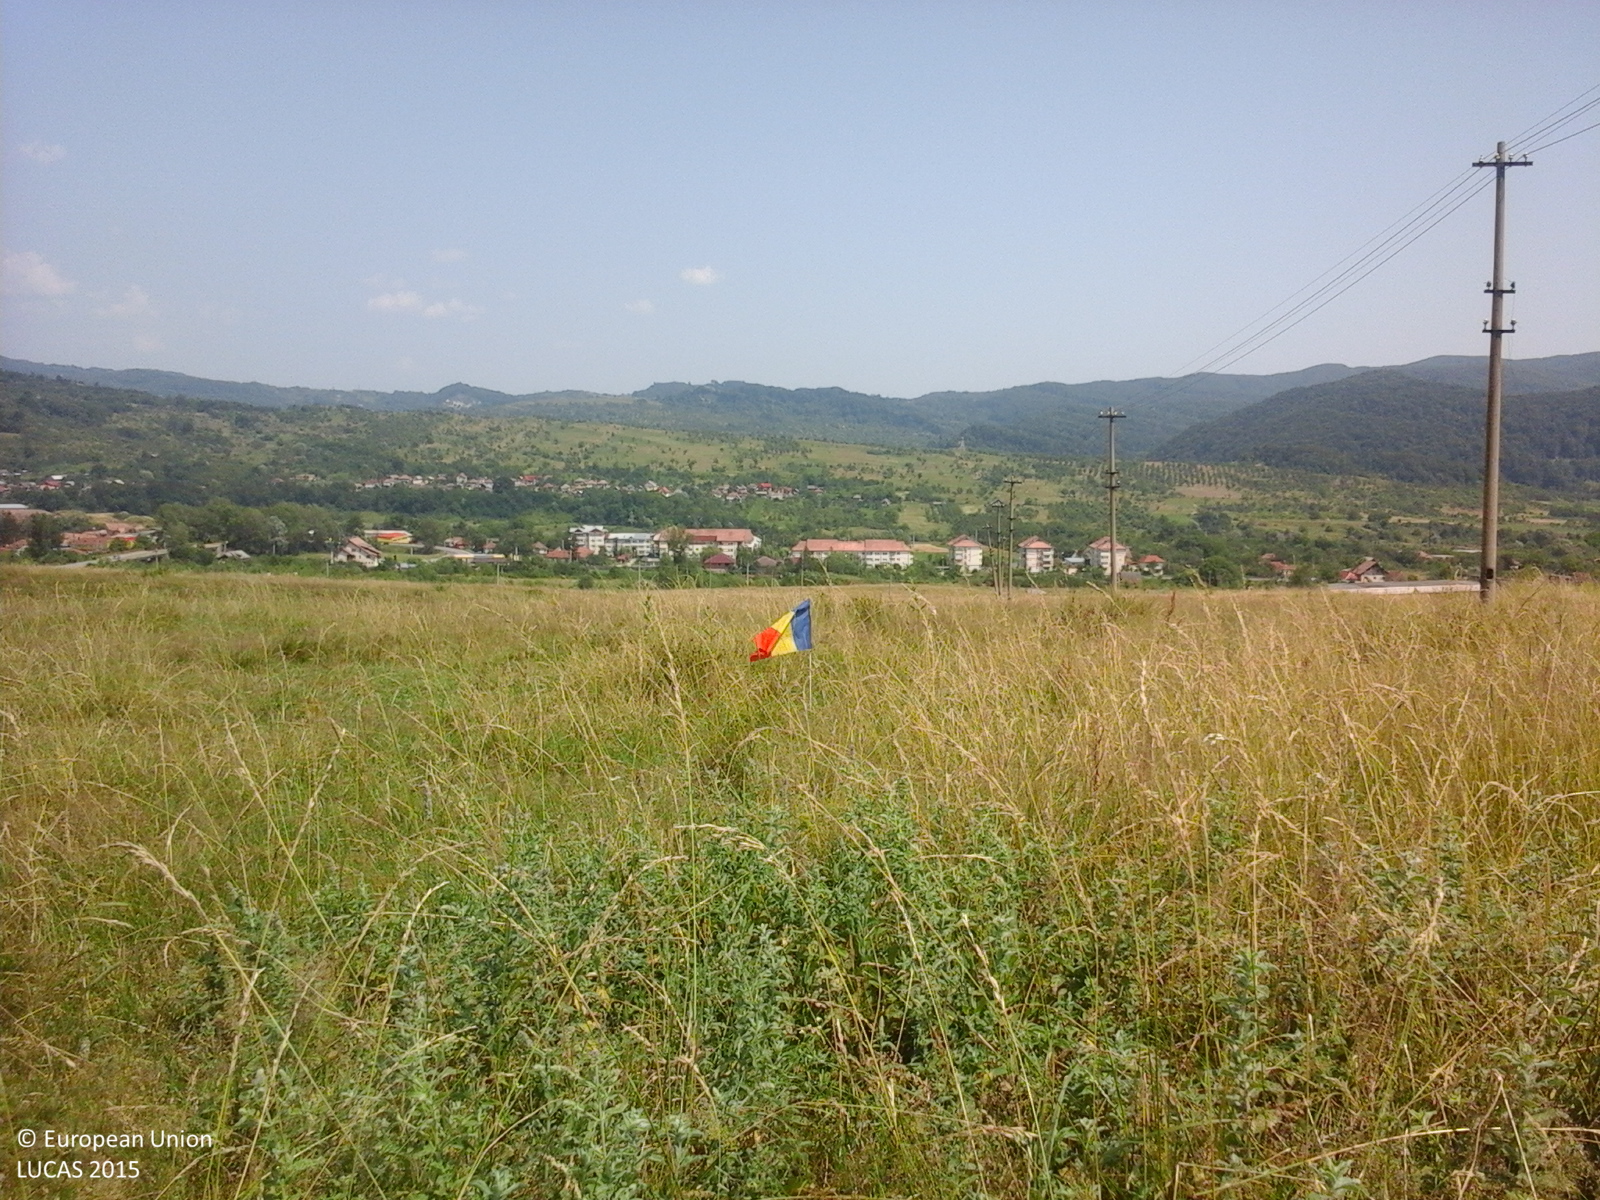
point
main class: Grassland
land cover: Grassland without tree/shrub cover
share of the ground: > 75 %
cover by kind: herbaceous plants 100 %
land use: Agriculture (excluding fallow land and kitchen gardens)
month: July
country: RO
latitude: 45.2130
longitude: 24.9978
